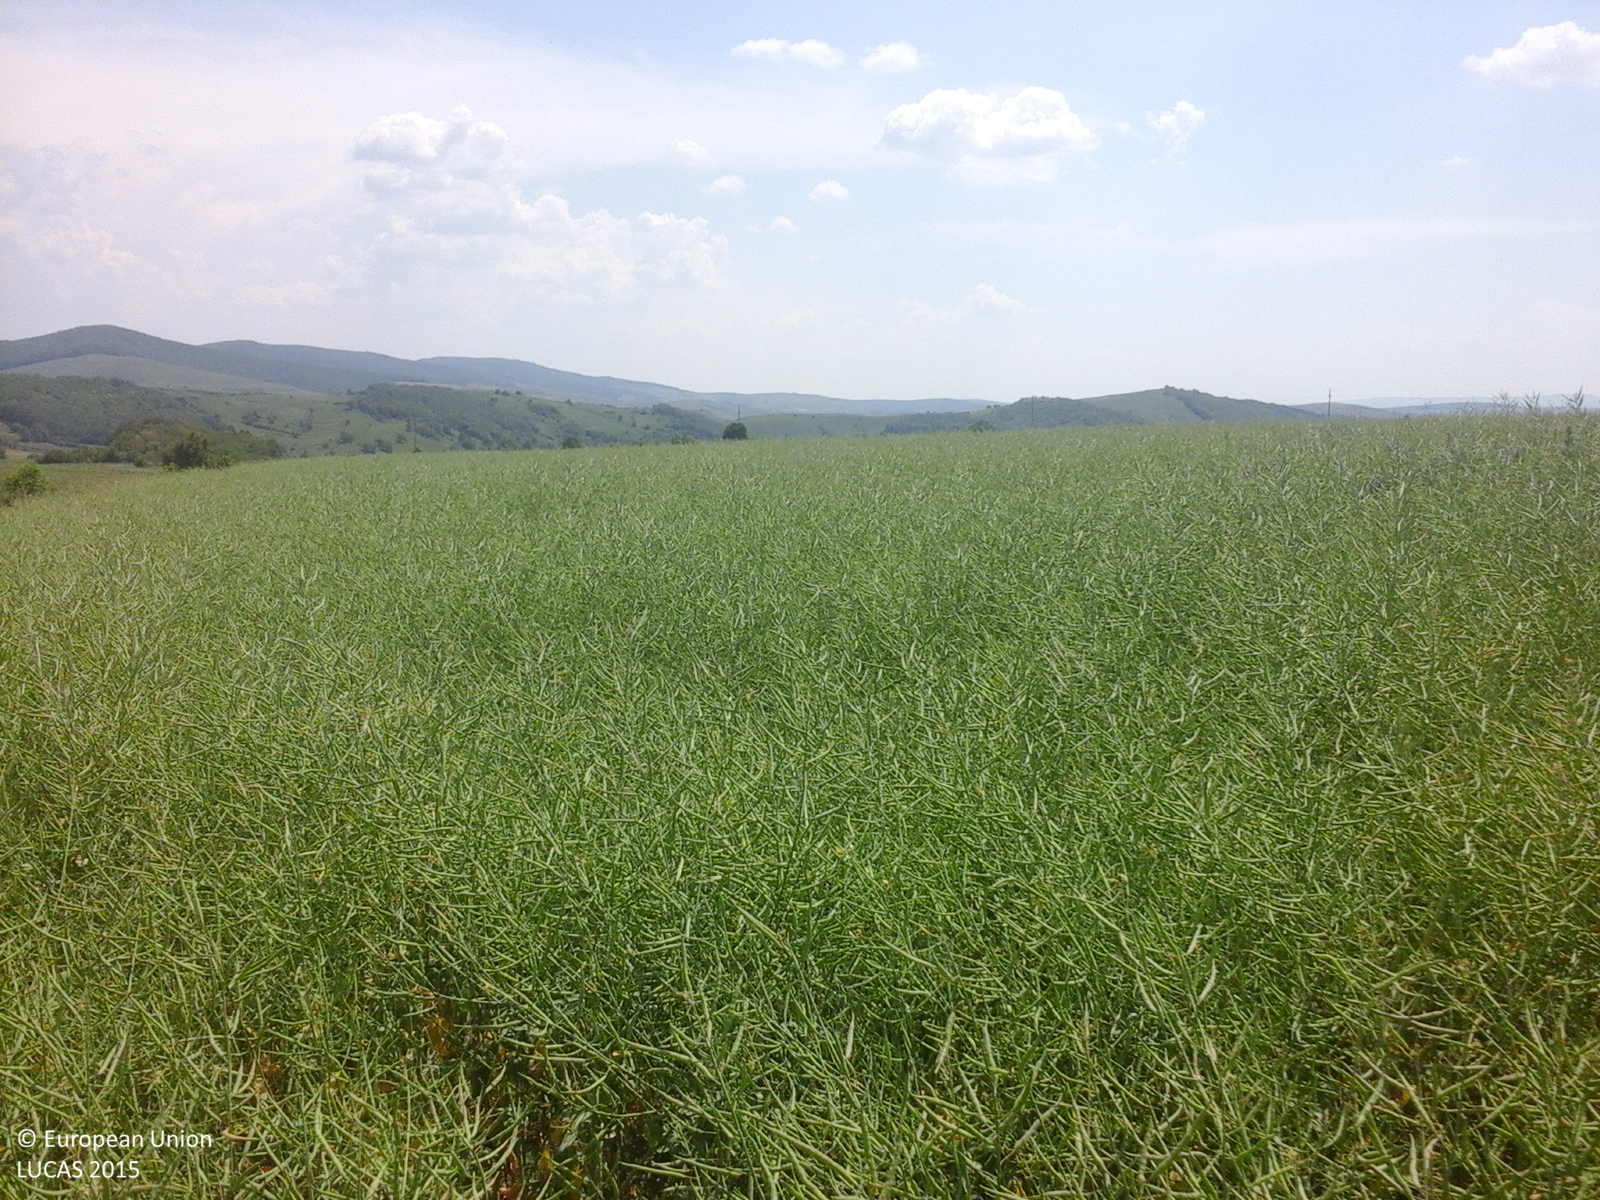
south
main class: Cropland
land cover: Rape and turnip rape
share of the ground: > 75 %
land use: Agriculture (excluding fallow land and kitchen gardens)
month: June
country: RO
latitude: 46.4663
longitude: 27.1191
